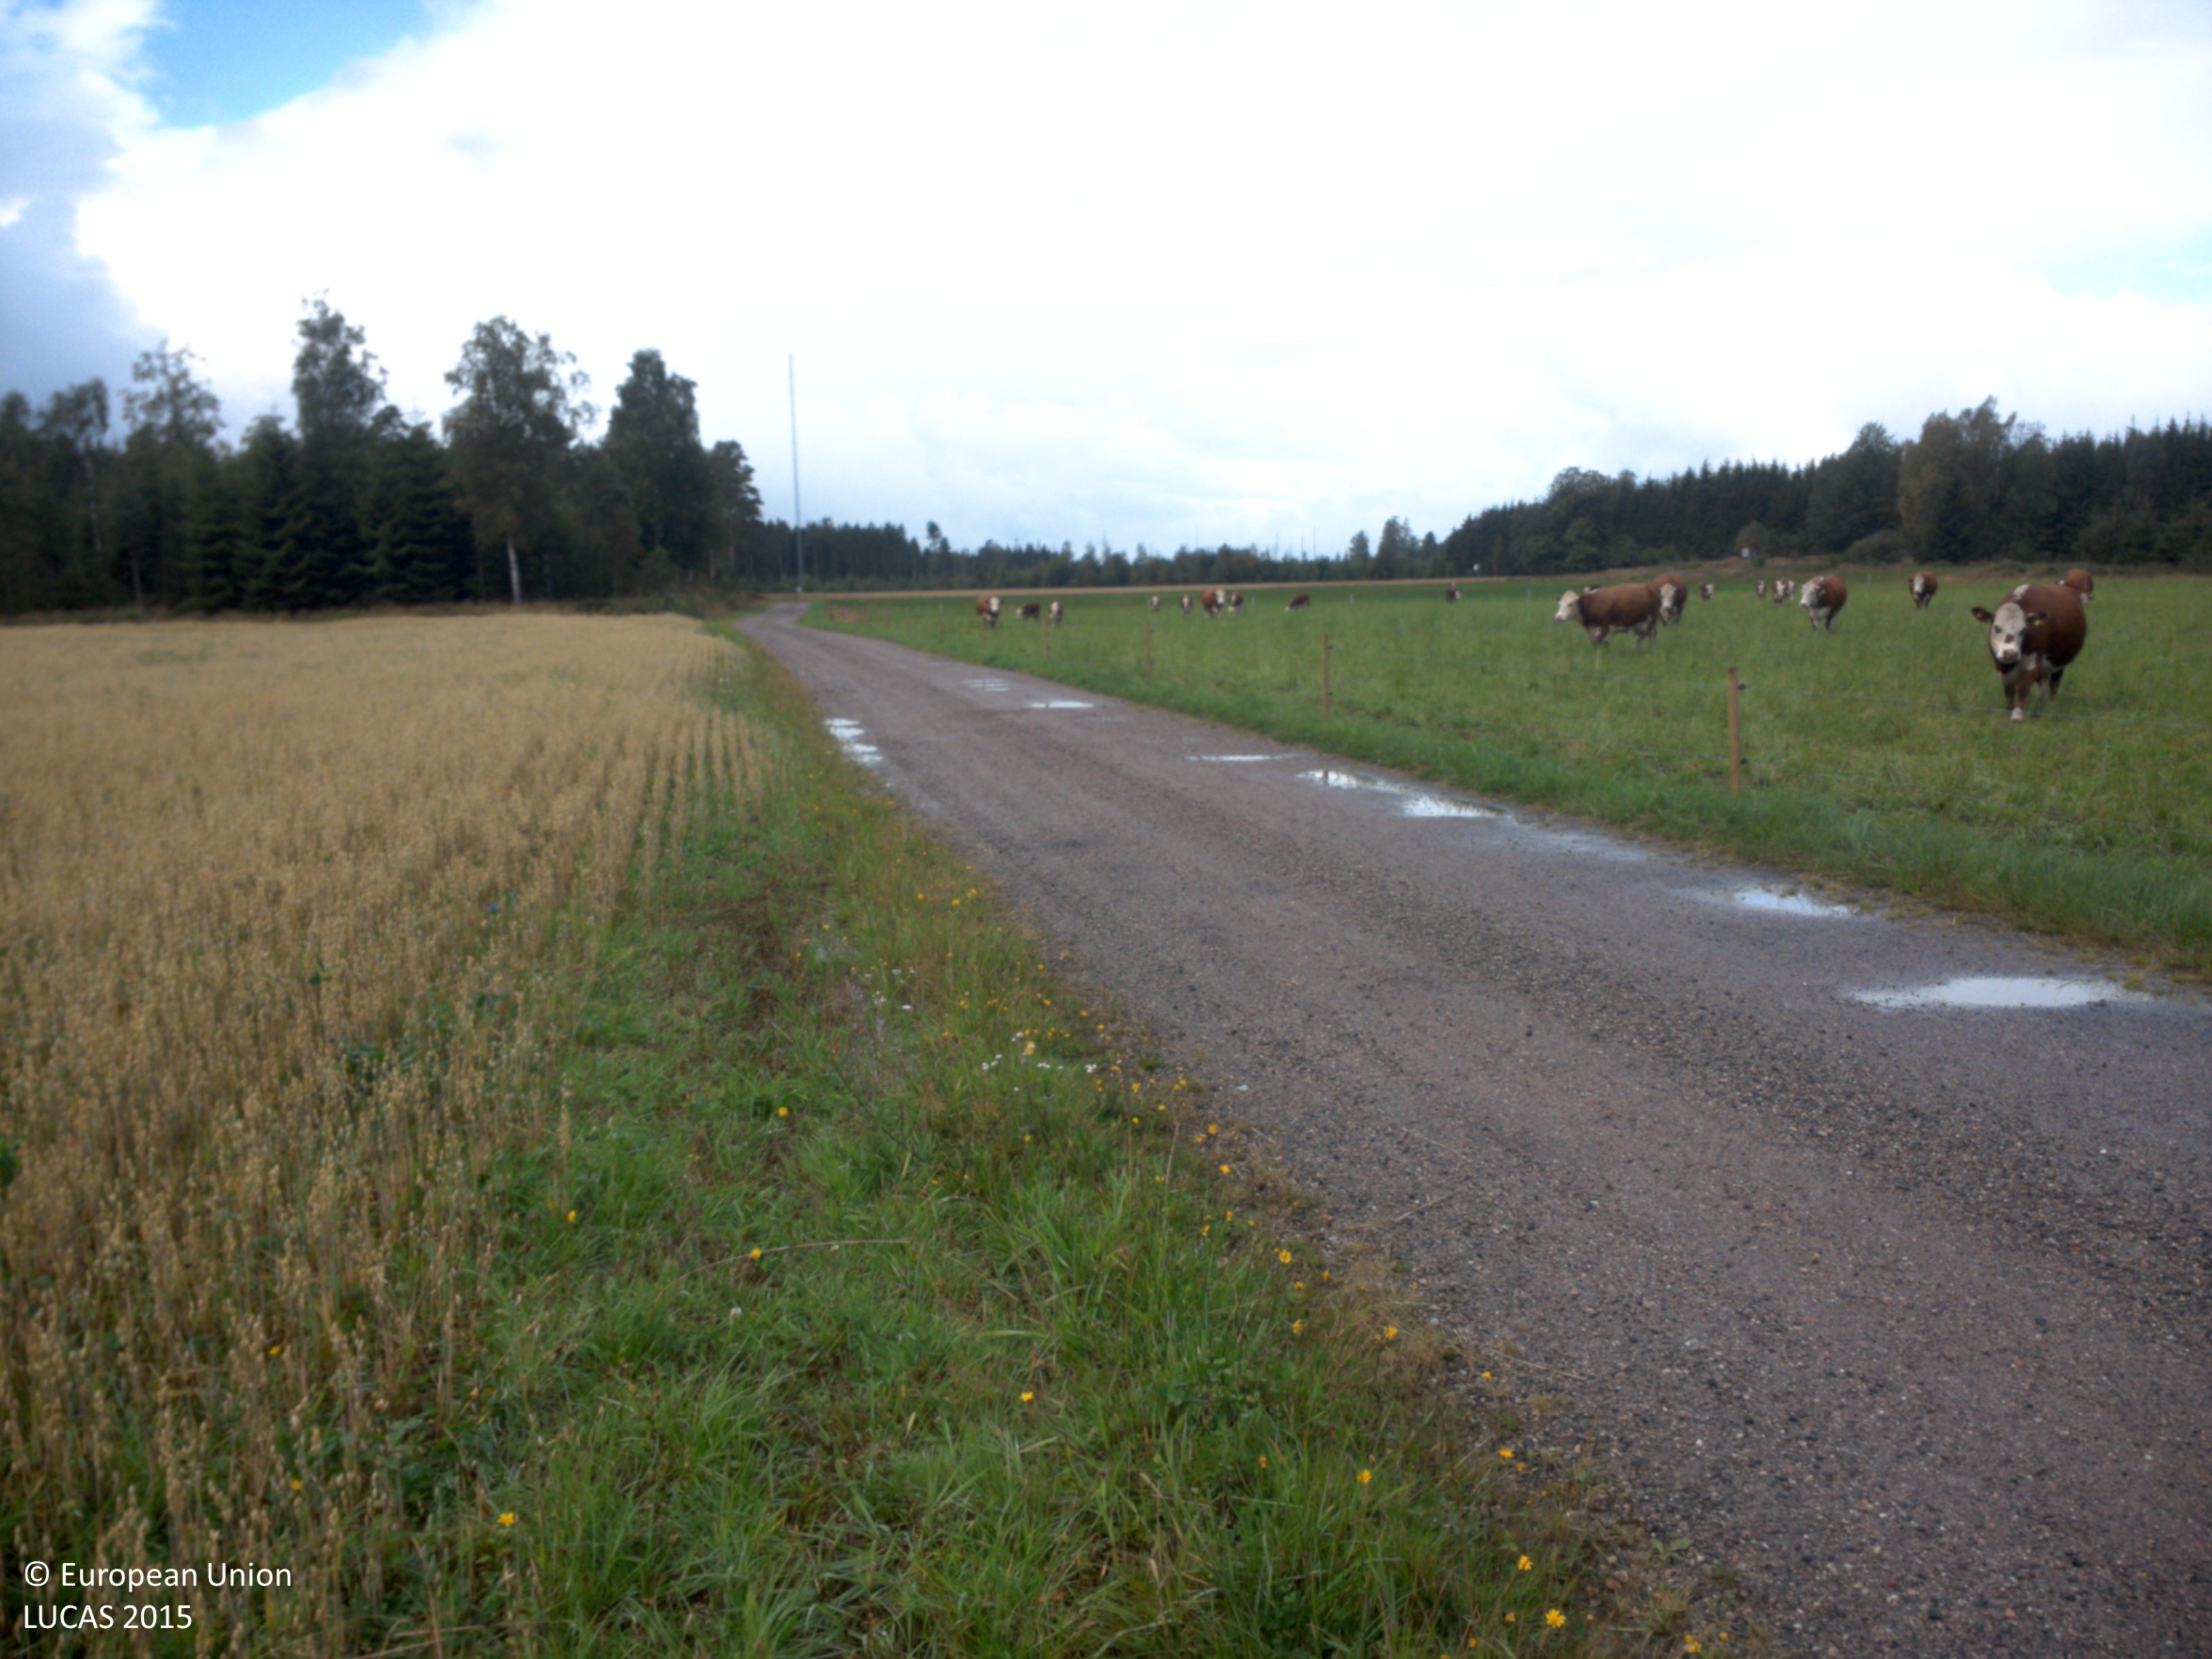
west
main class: Cropland
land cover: Oats
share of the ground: > 75 %
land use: Agriculture (excluding fallow land and kitchen gardens)
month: August
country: SE
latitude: 58.3449
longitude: 12.2336
